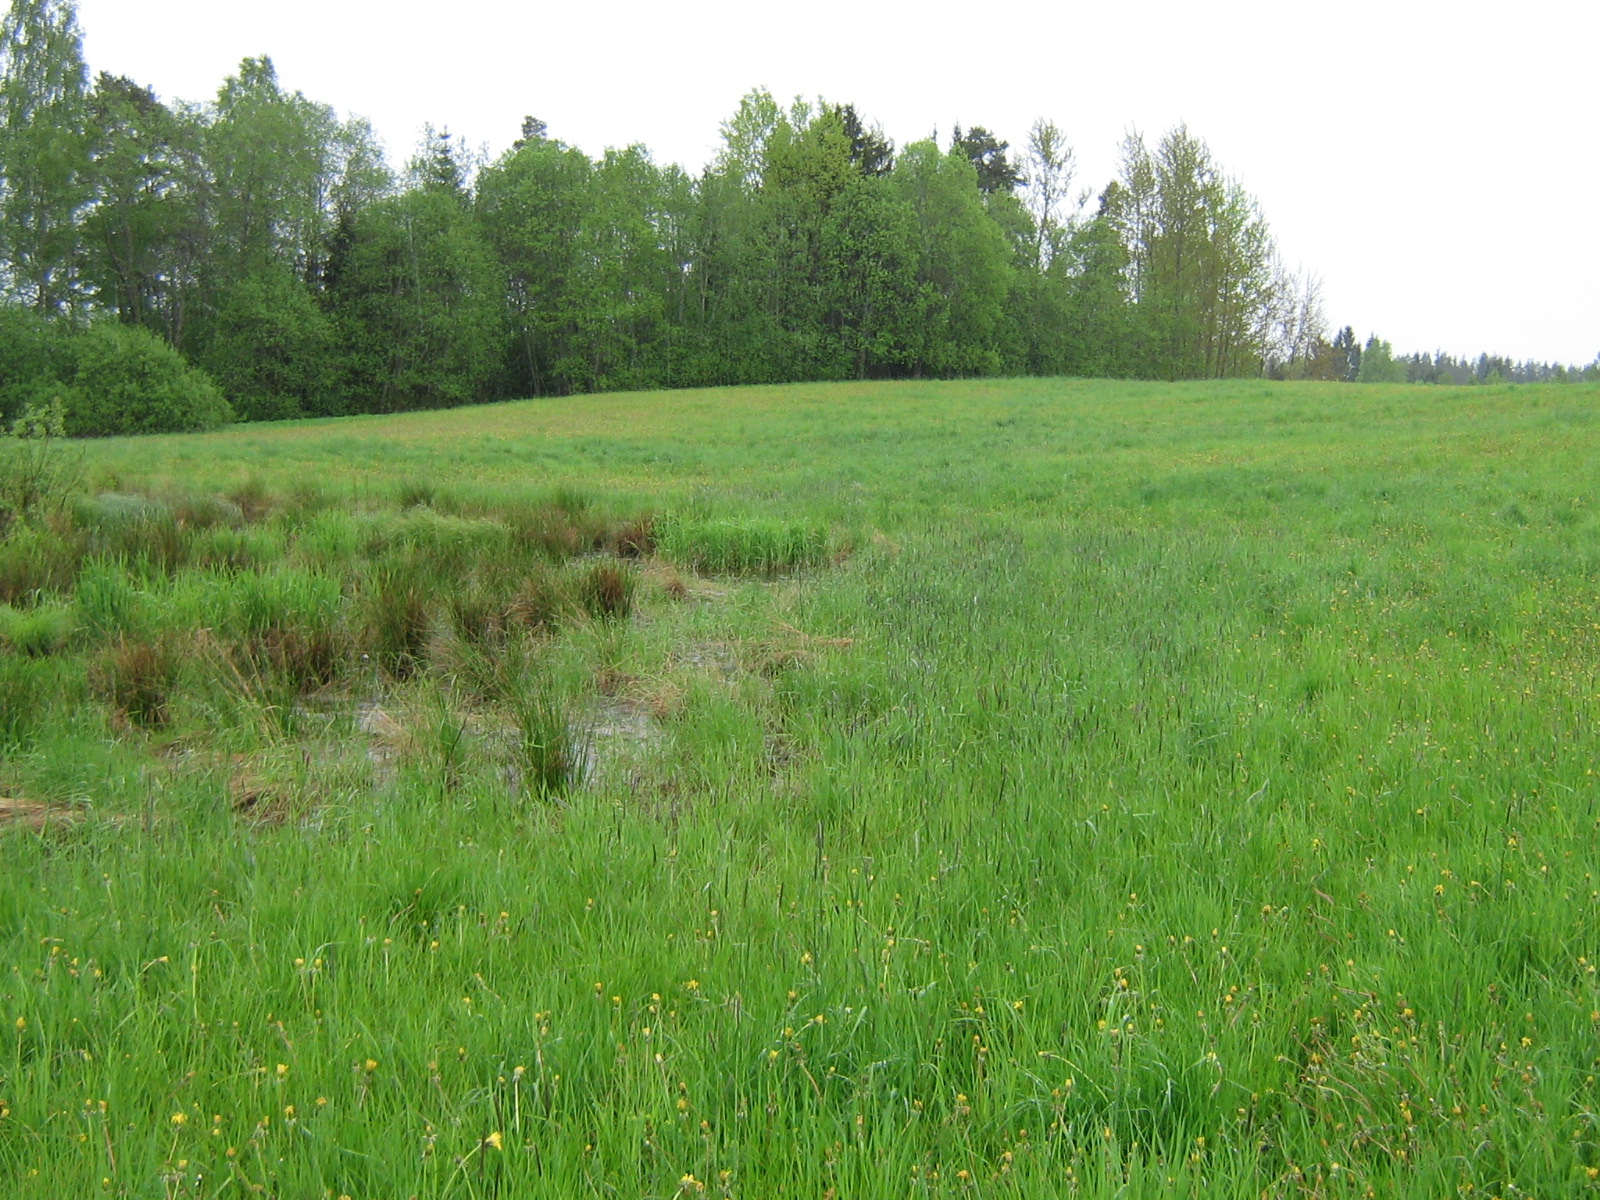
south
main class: Grassland
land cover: Grassland without tree/shrub cover
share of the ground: > 75 %
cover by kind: herbaceous plants 100 %
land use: Agriculture (excluding fallow land and kitchen gardens)
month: May
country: LV
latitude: 57.2563
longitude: 25.9595
